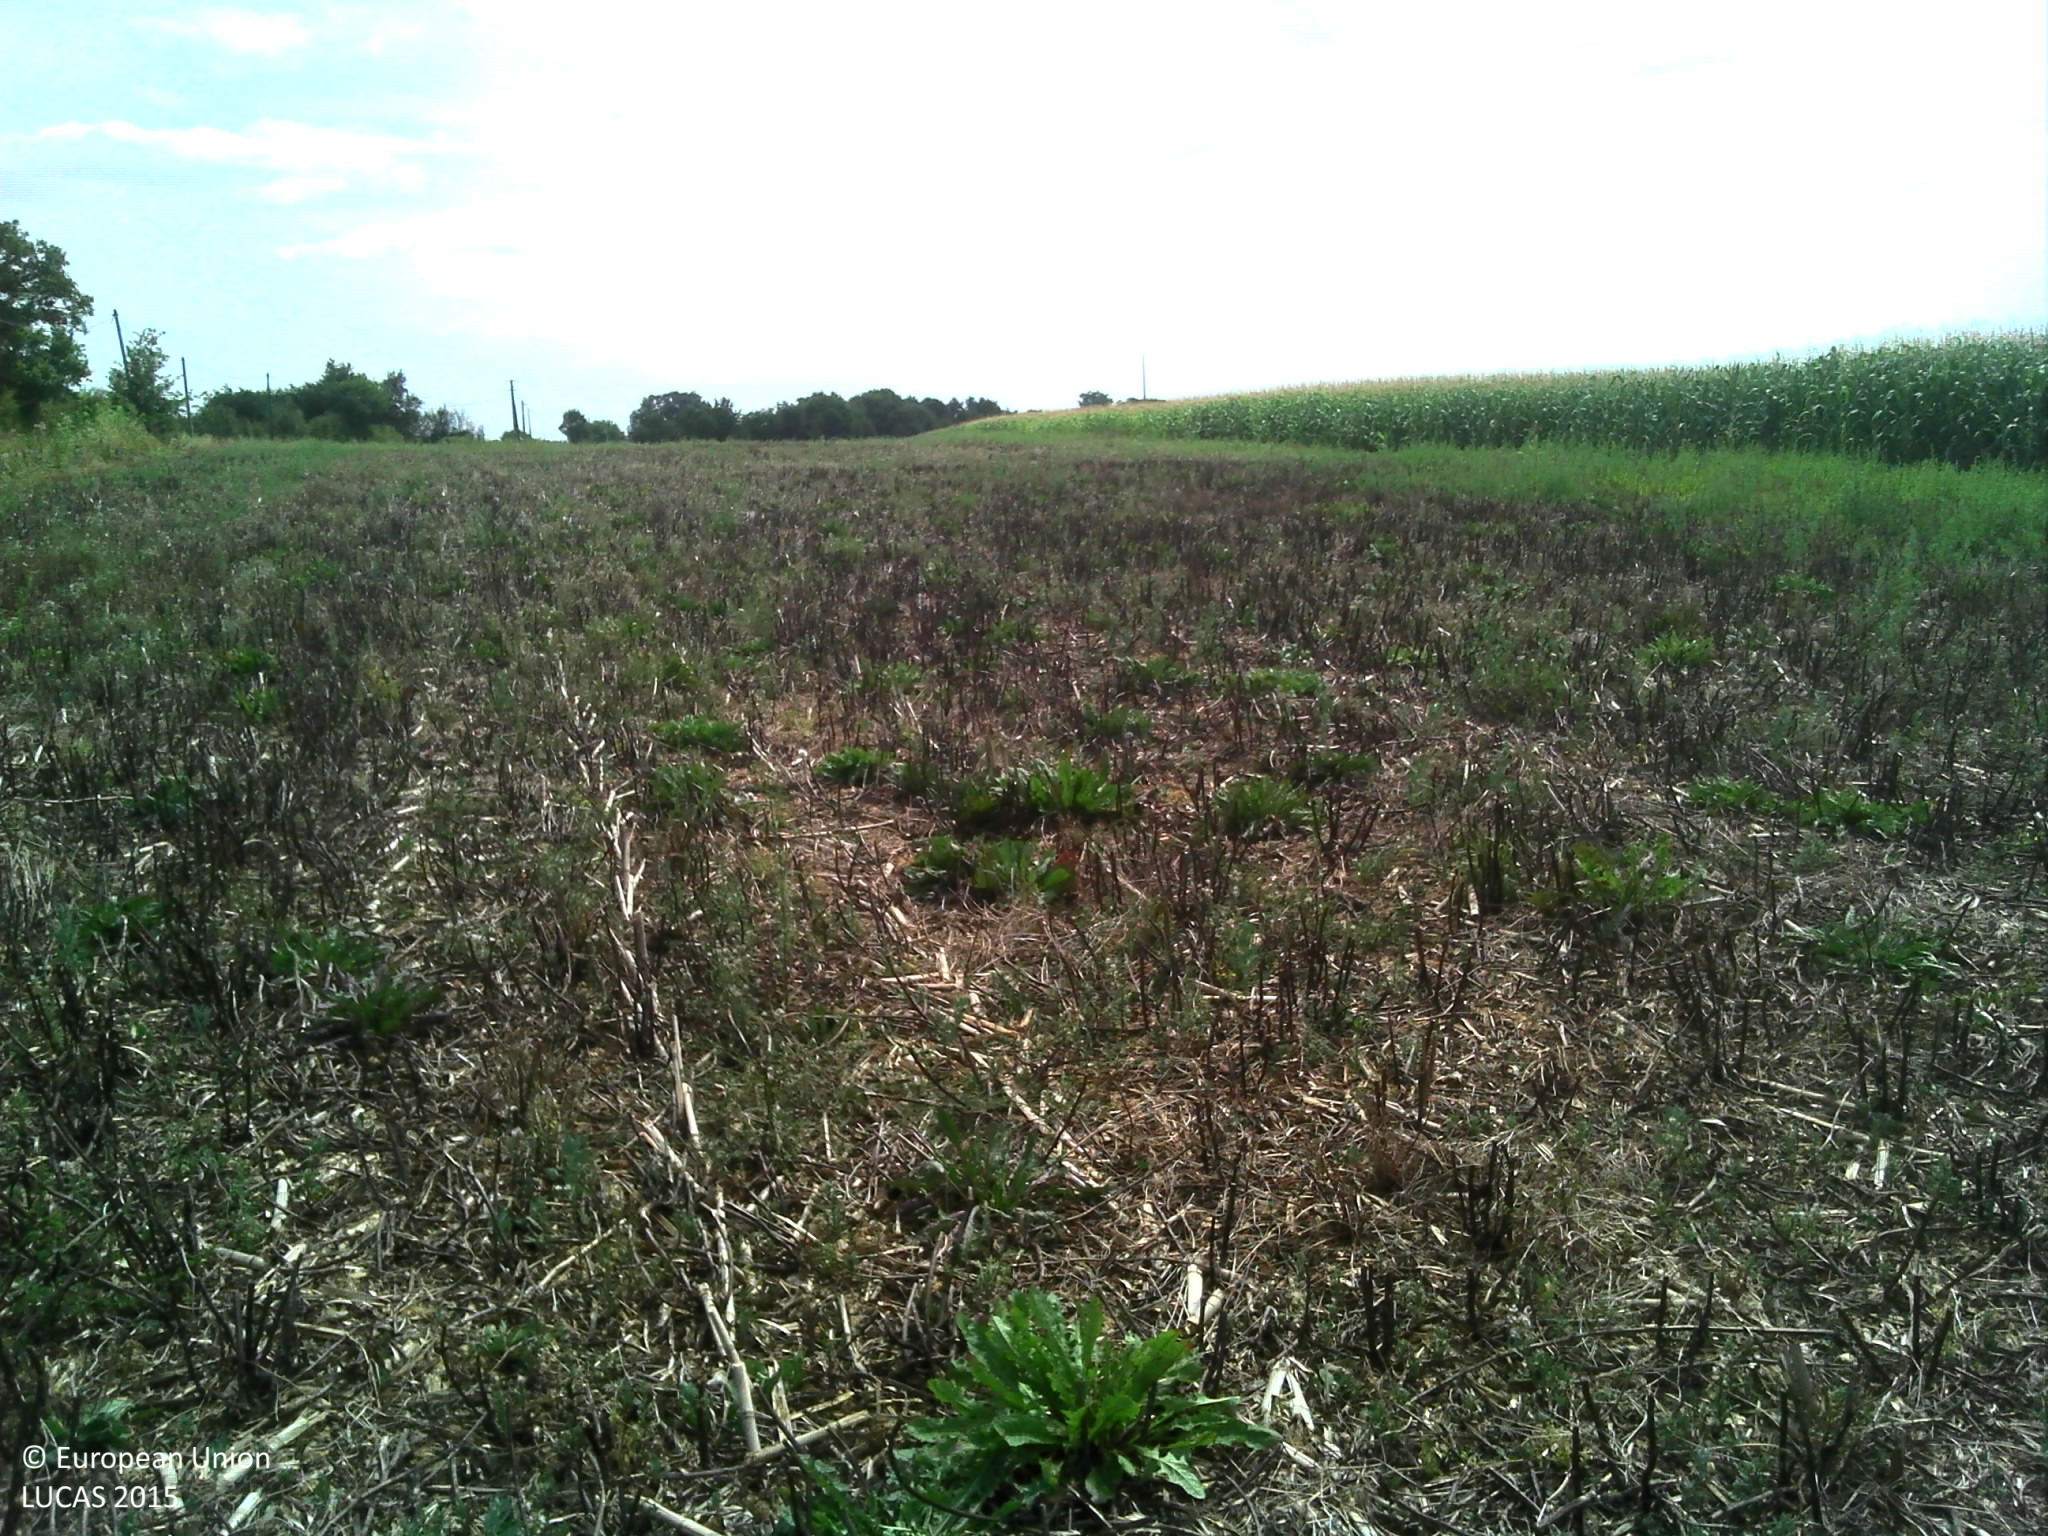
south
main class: Cropland
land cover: Dry pulses
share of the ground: > 75 %
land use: Agriculture (excluding fallow land and kitchen gardens)
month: August
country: FR
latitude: 46.6288
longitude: -1.0699
